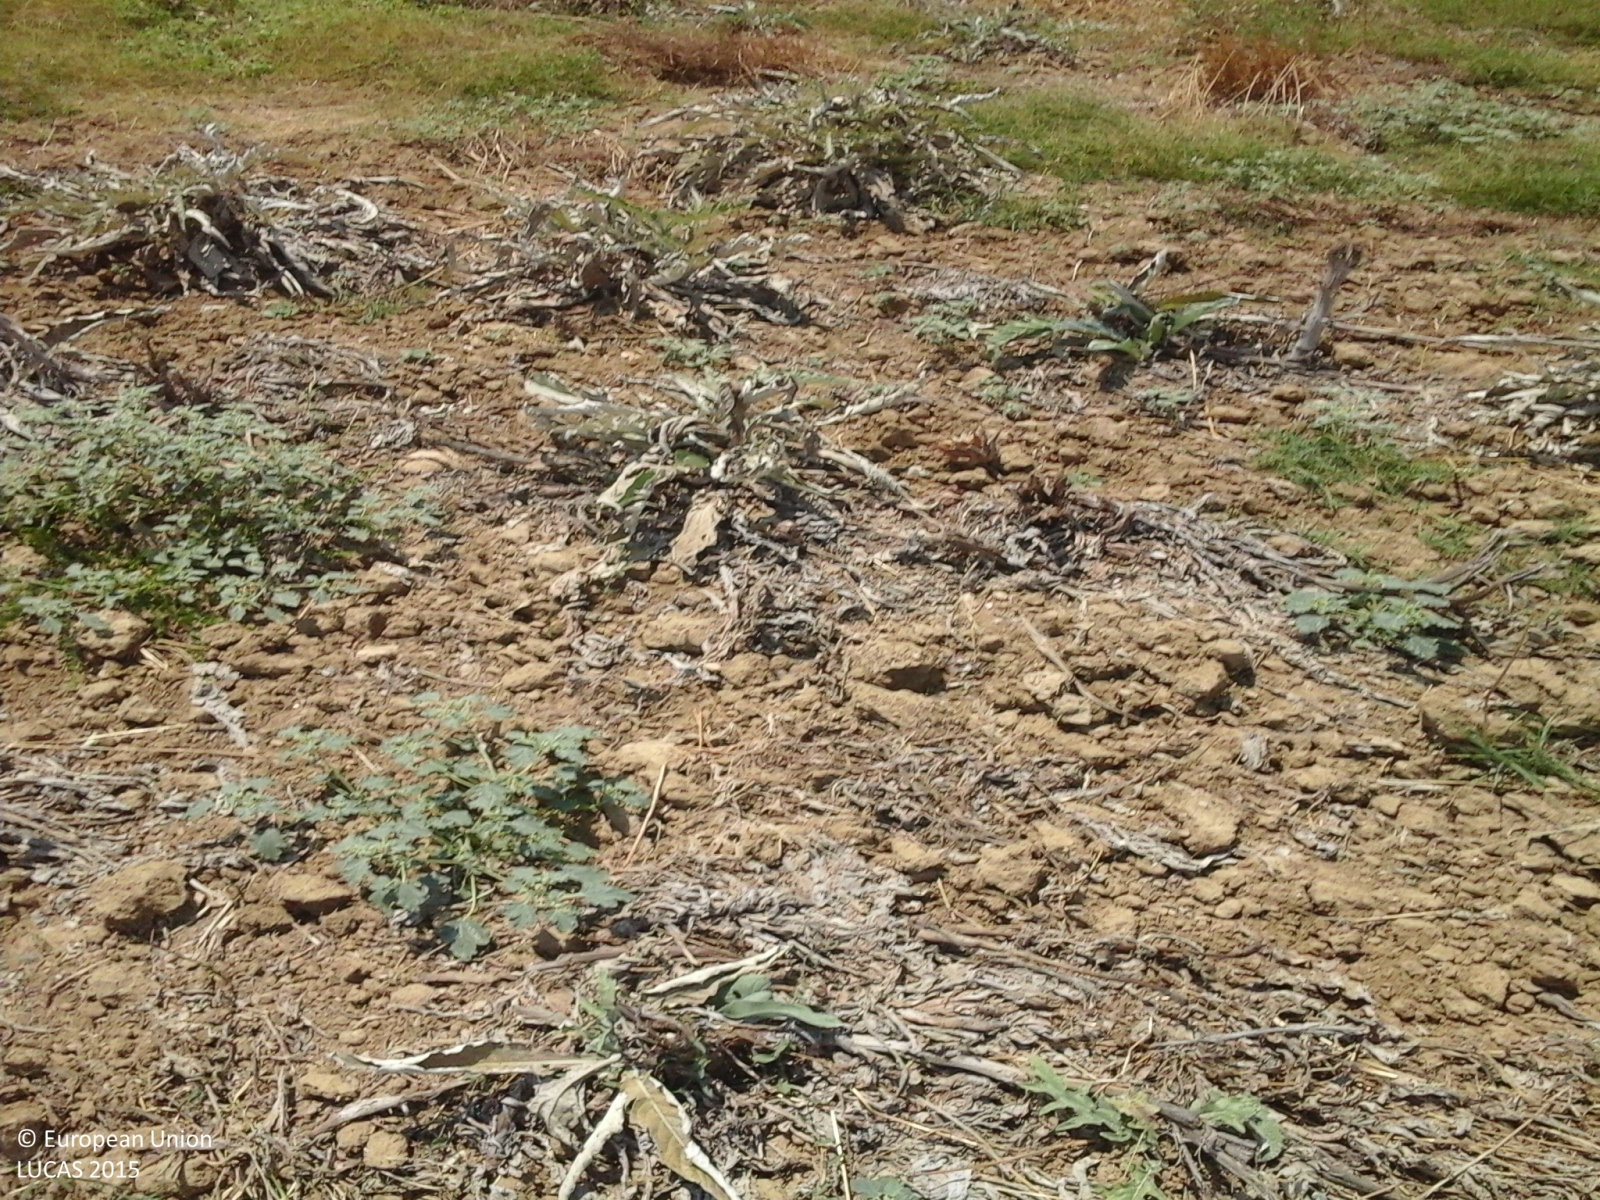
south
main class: Cropland
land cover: Other fresh vegetables
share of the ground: > 75 %
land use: Agriculture (excluding fallow land and kitchen gardens)
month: July
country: IT
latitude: 37.1200
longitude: 14.3665
